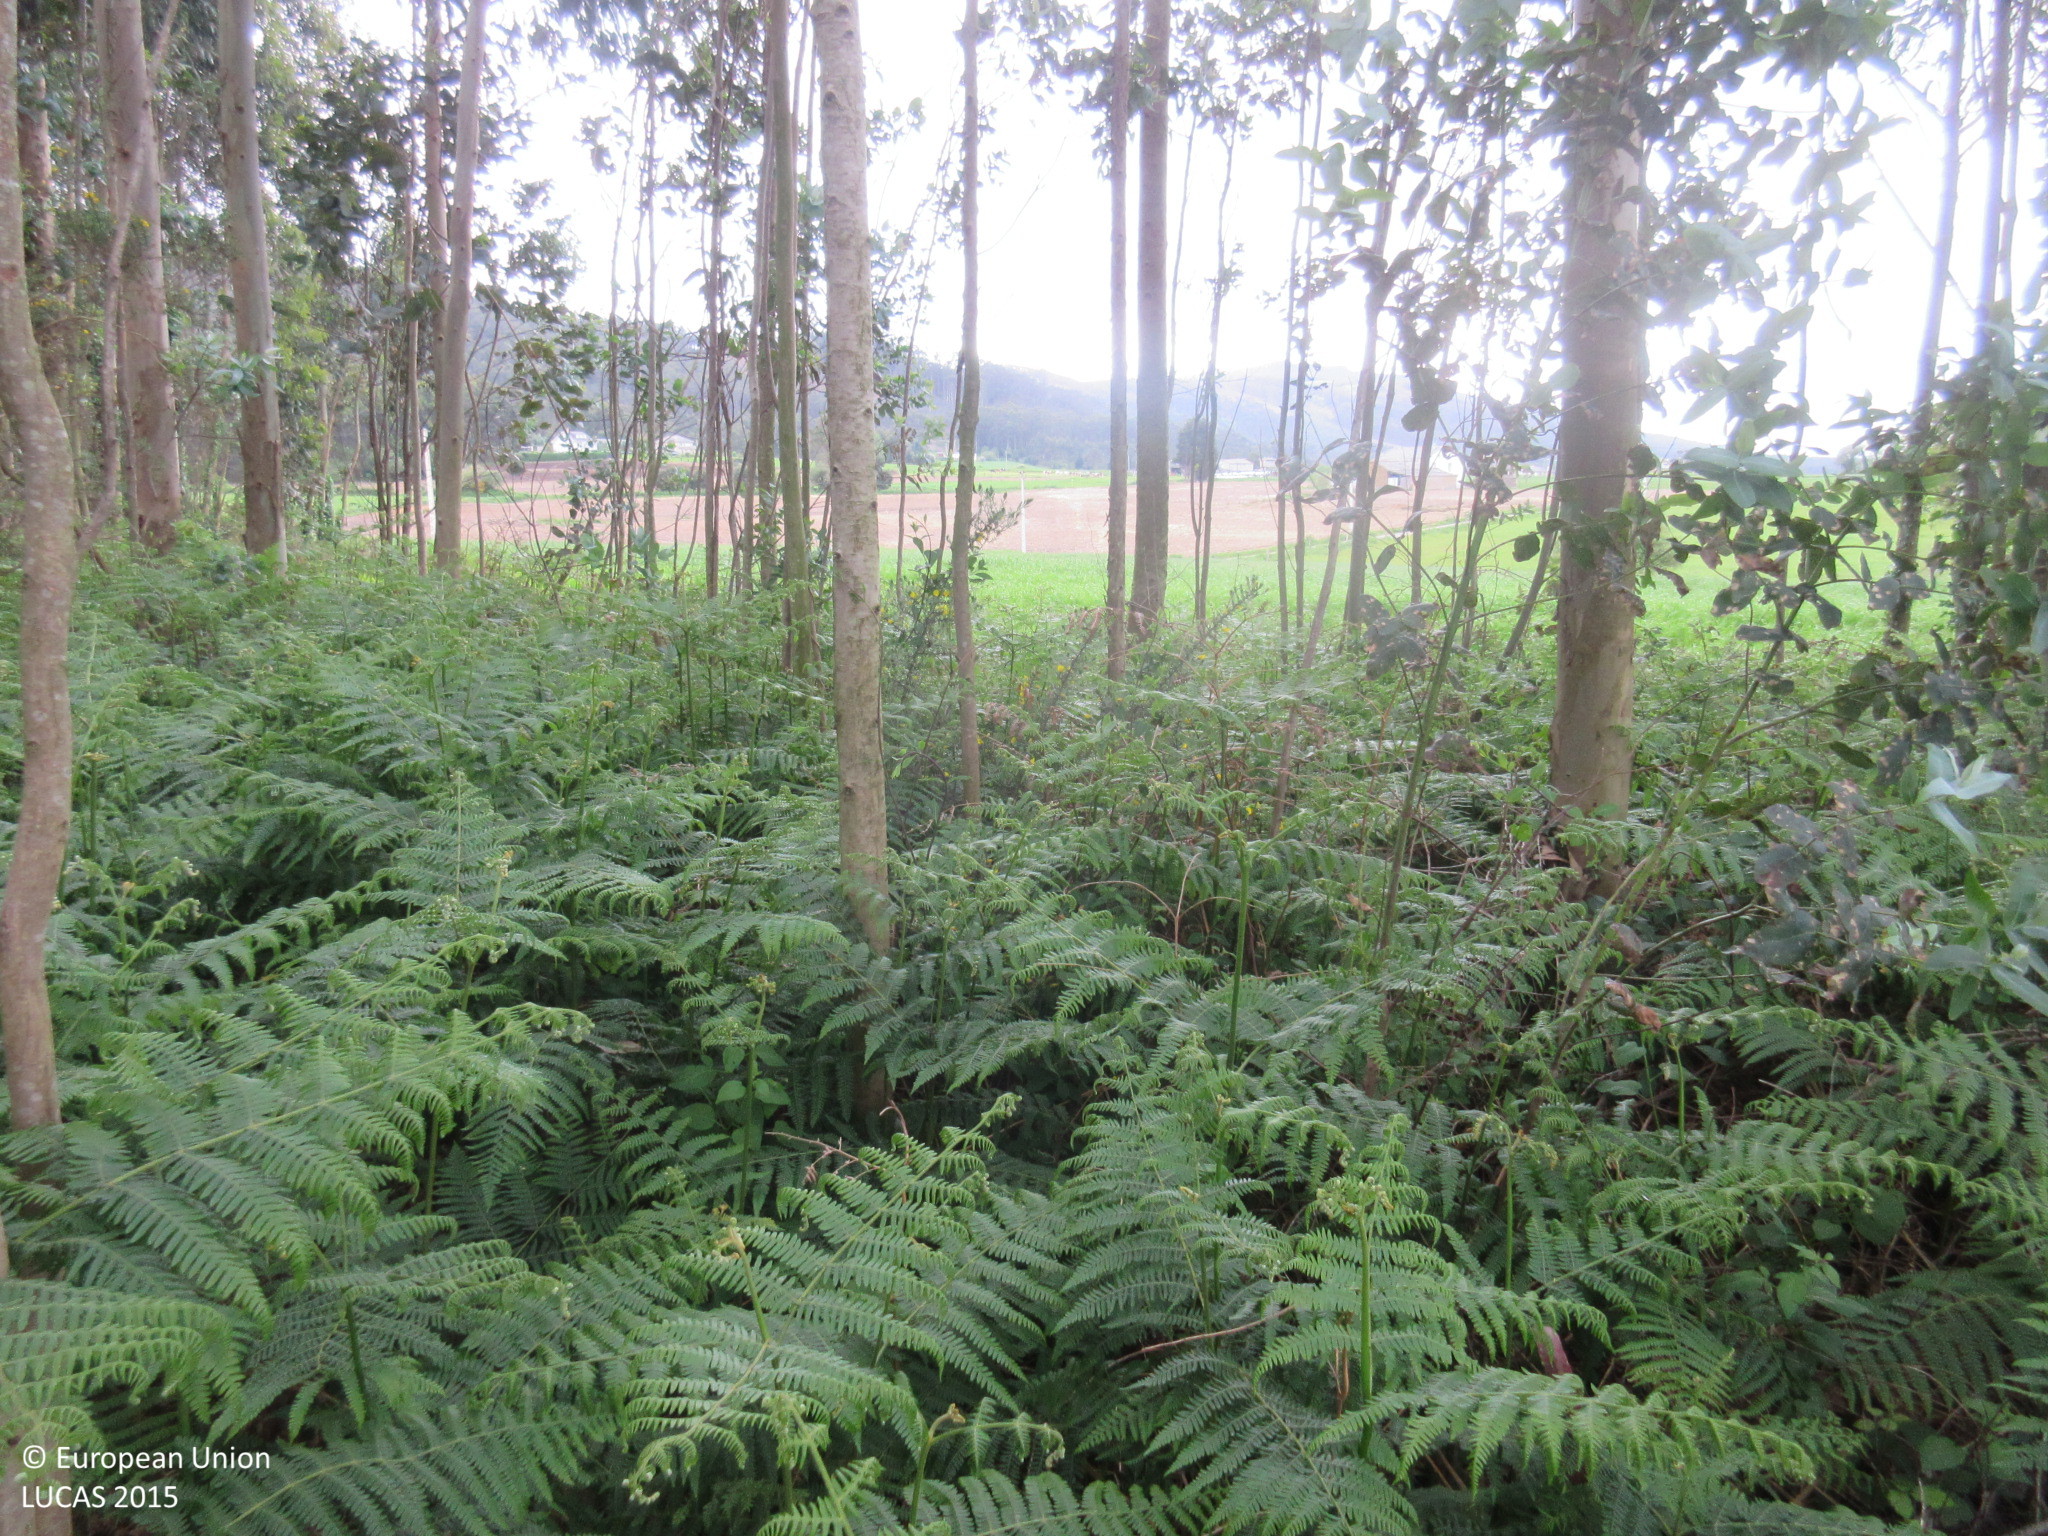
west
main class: Woodland
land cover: Broadleaved woodland
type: exotic forest
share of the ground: > 75 %
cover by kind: broadleaved forest trees 95 %, shrubs 5 %
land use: Forestry
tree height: > 5 m
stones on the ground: < 10 %
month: April
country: ES
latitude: 43.5418
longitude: -7.1132
